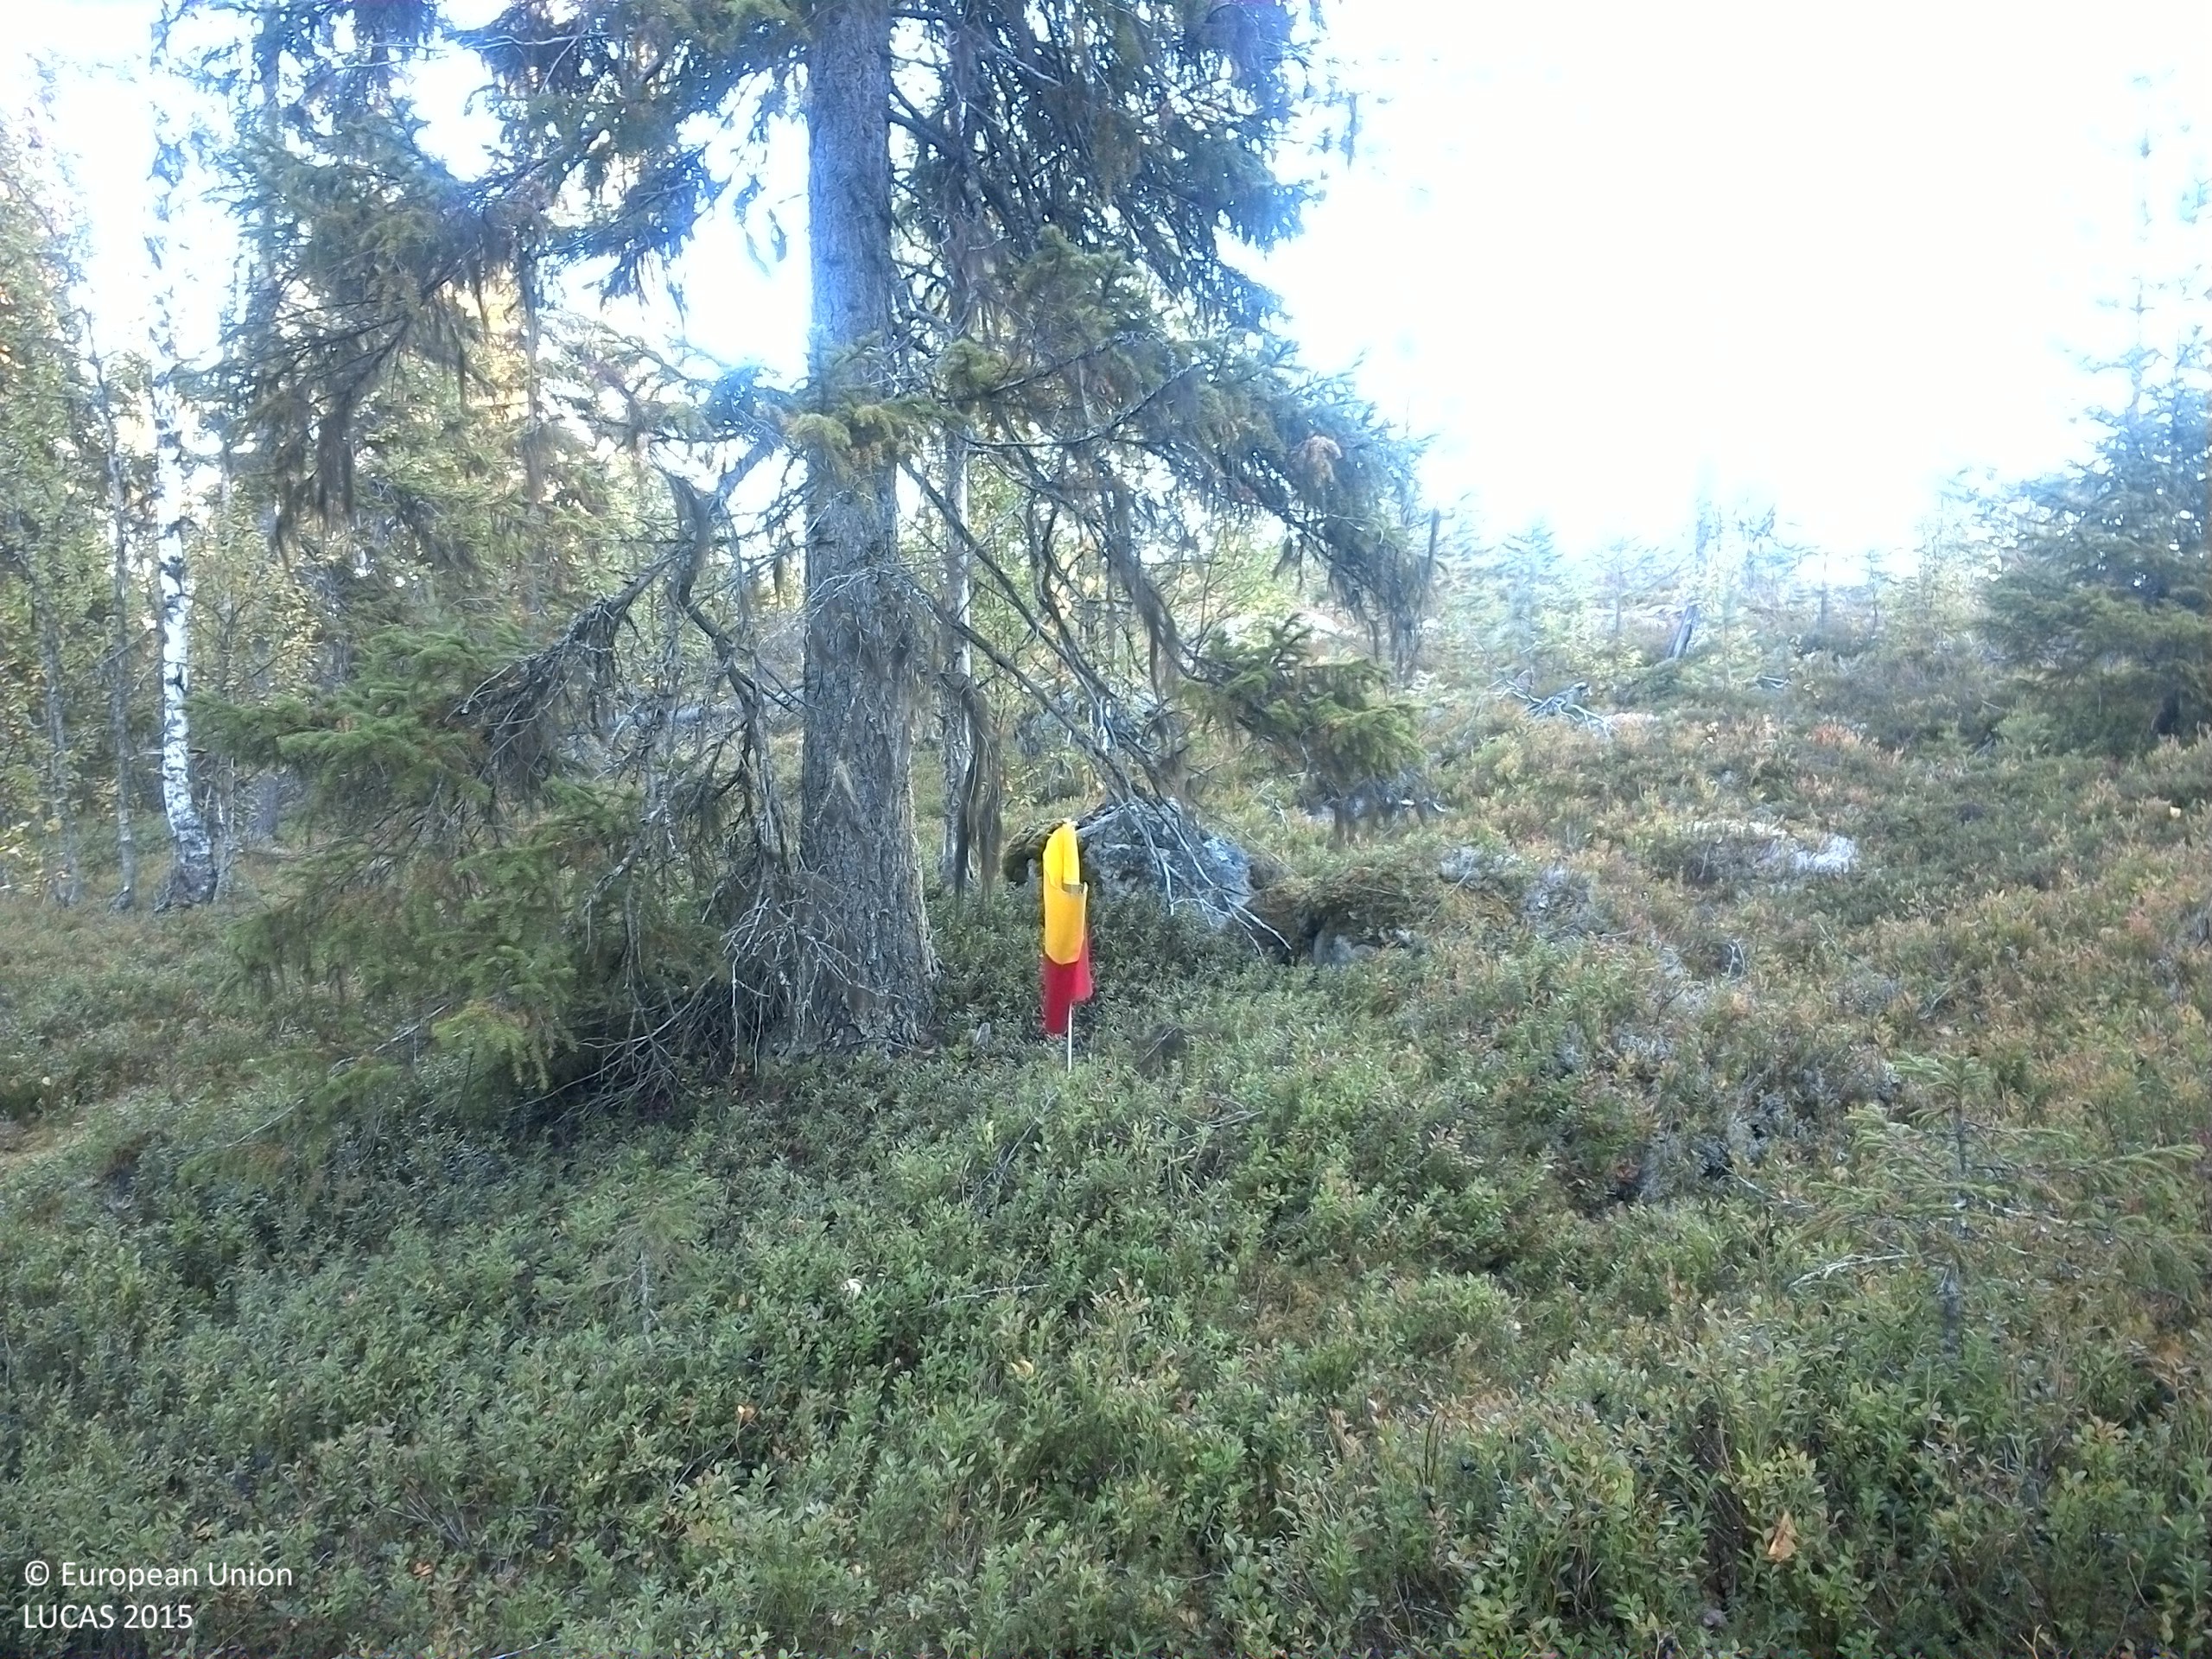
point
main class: Woodland
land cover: Pine dominated mixed woodland
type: boreal forest
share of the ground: 10 - 25 %
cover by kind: shrubs 55 %, coniferous forest trees 15 %, lichens and mosses 15 %, broadleaved forest trees 10 %, consolidated bare surface 5 %
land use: Forestry
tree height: > 5 m
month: September
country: SE
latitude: 63.8721
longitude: 16.7897
